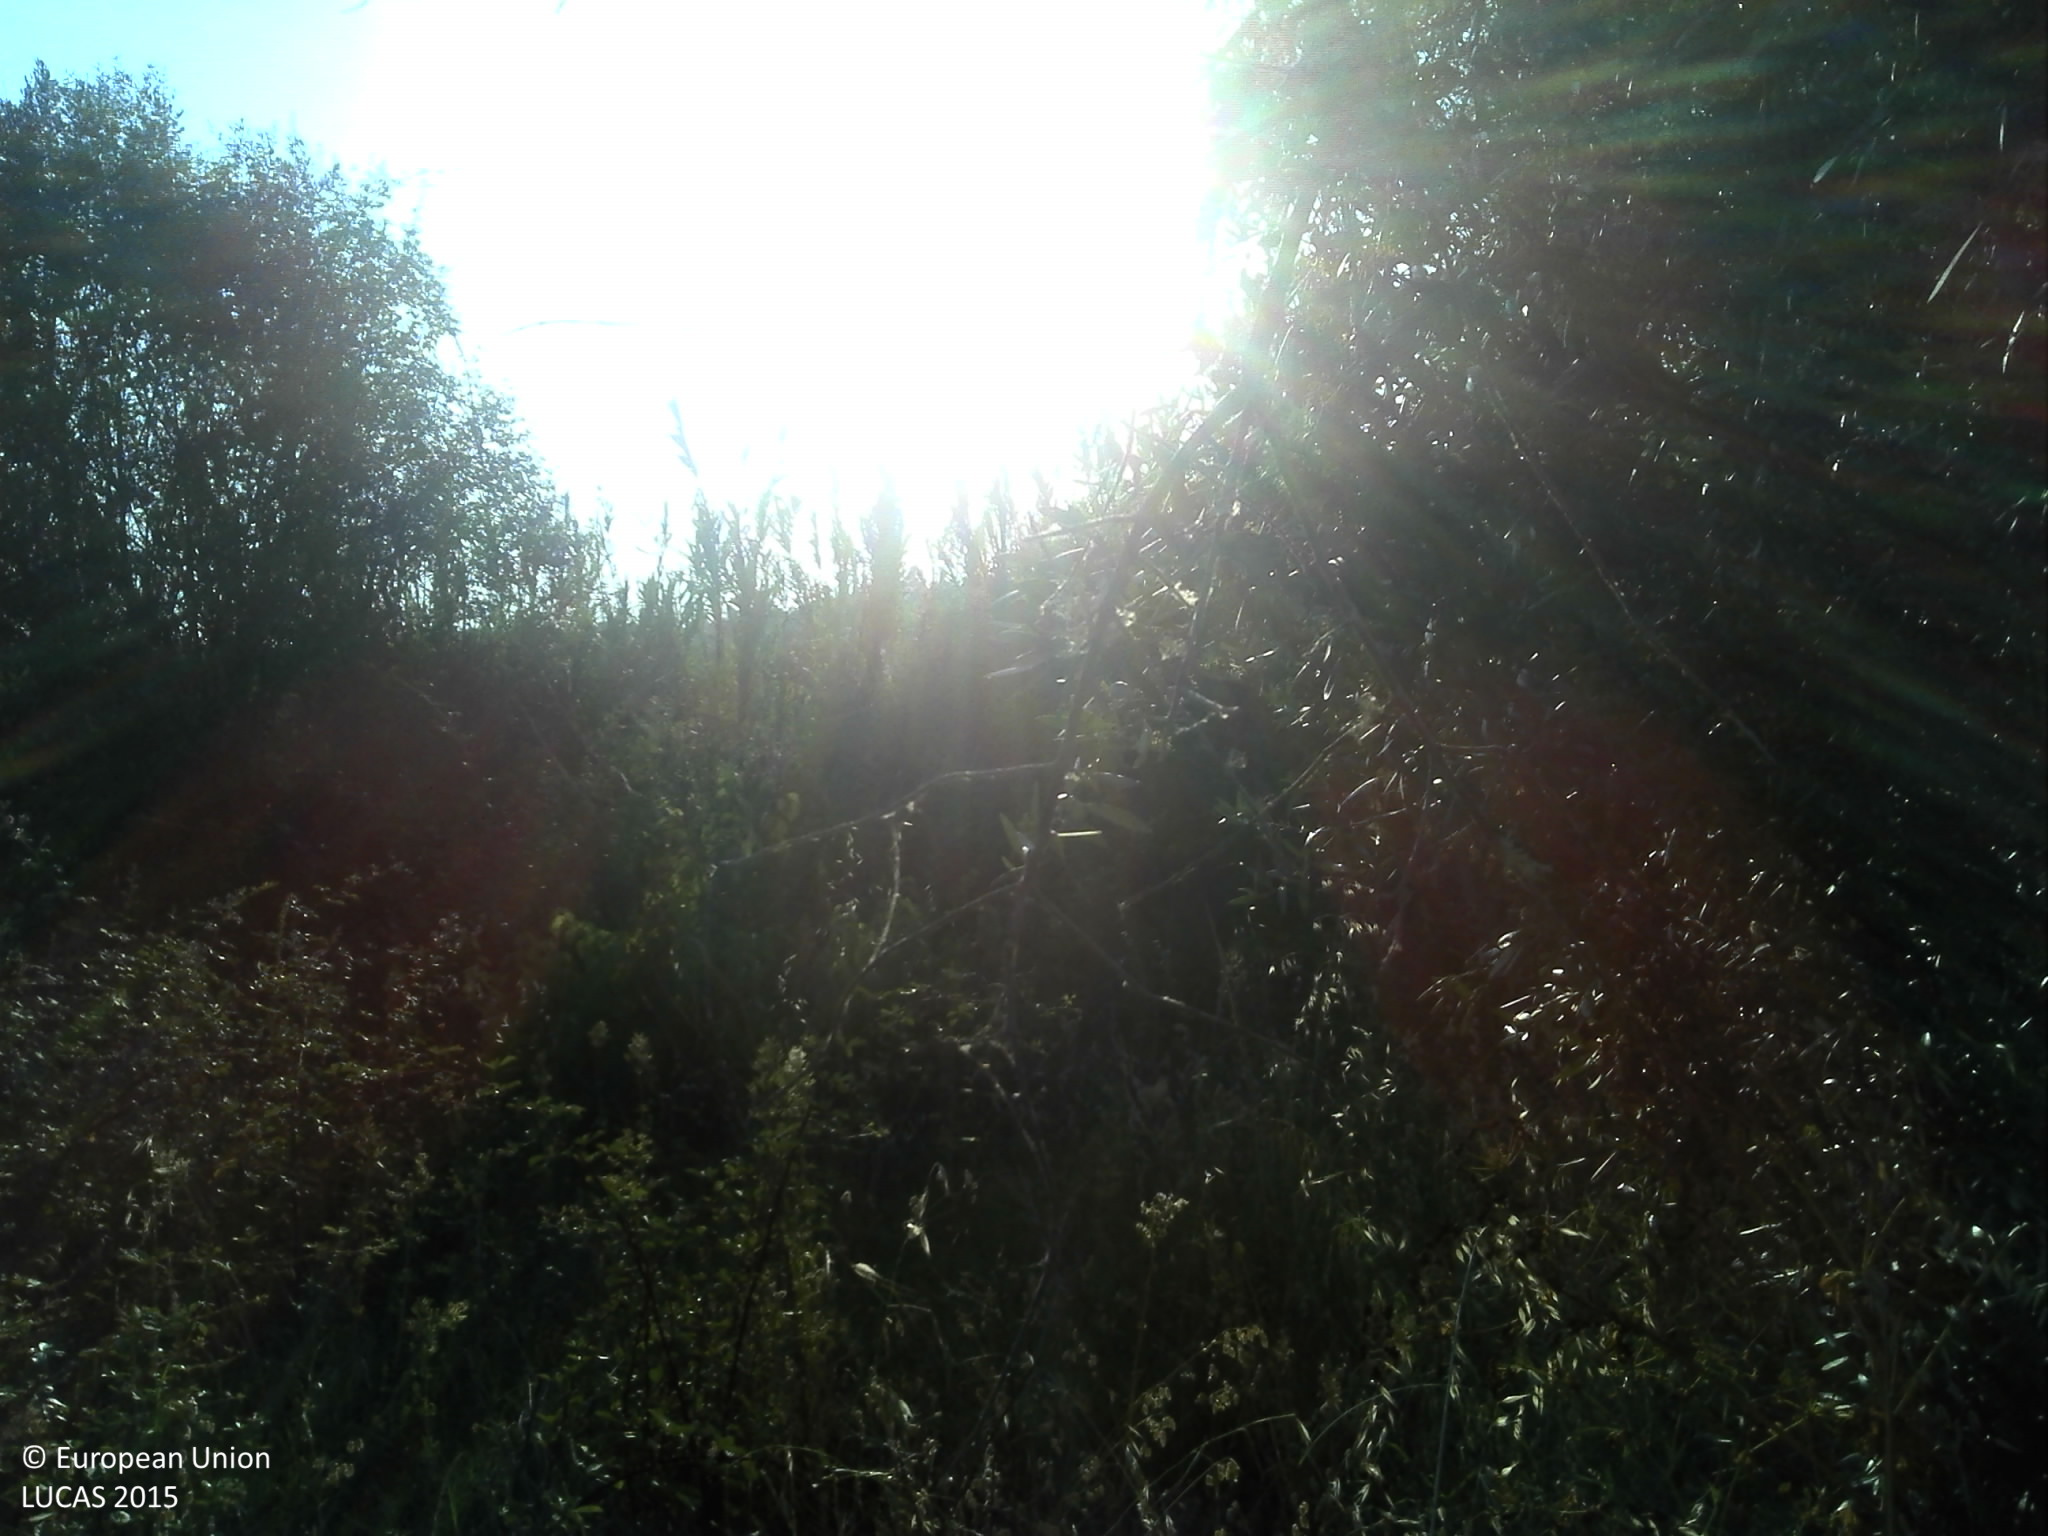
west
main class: Cropland
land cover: Olive groves
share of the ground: 25 - 50 %
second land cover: Shrubland without tree cover
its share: 50 - 75 %
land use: Agriculture (excluding fallow land and kitchen gardens)
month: June
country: PT
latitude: 39.3654
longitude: -7.9887
